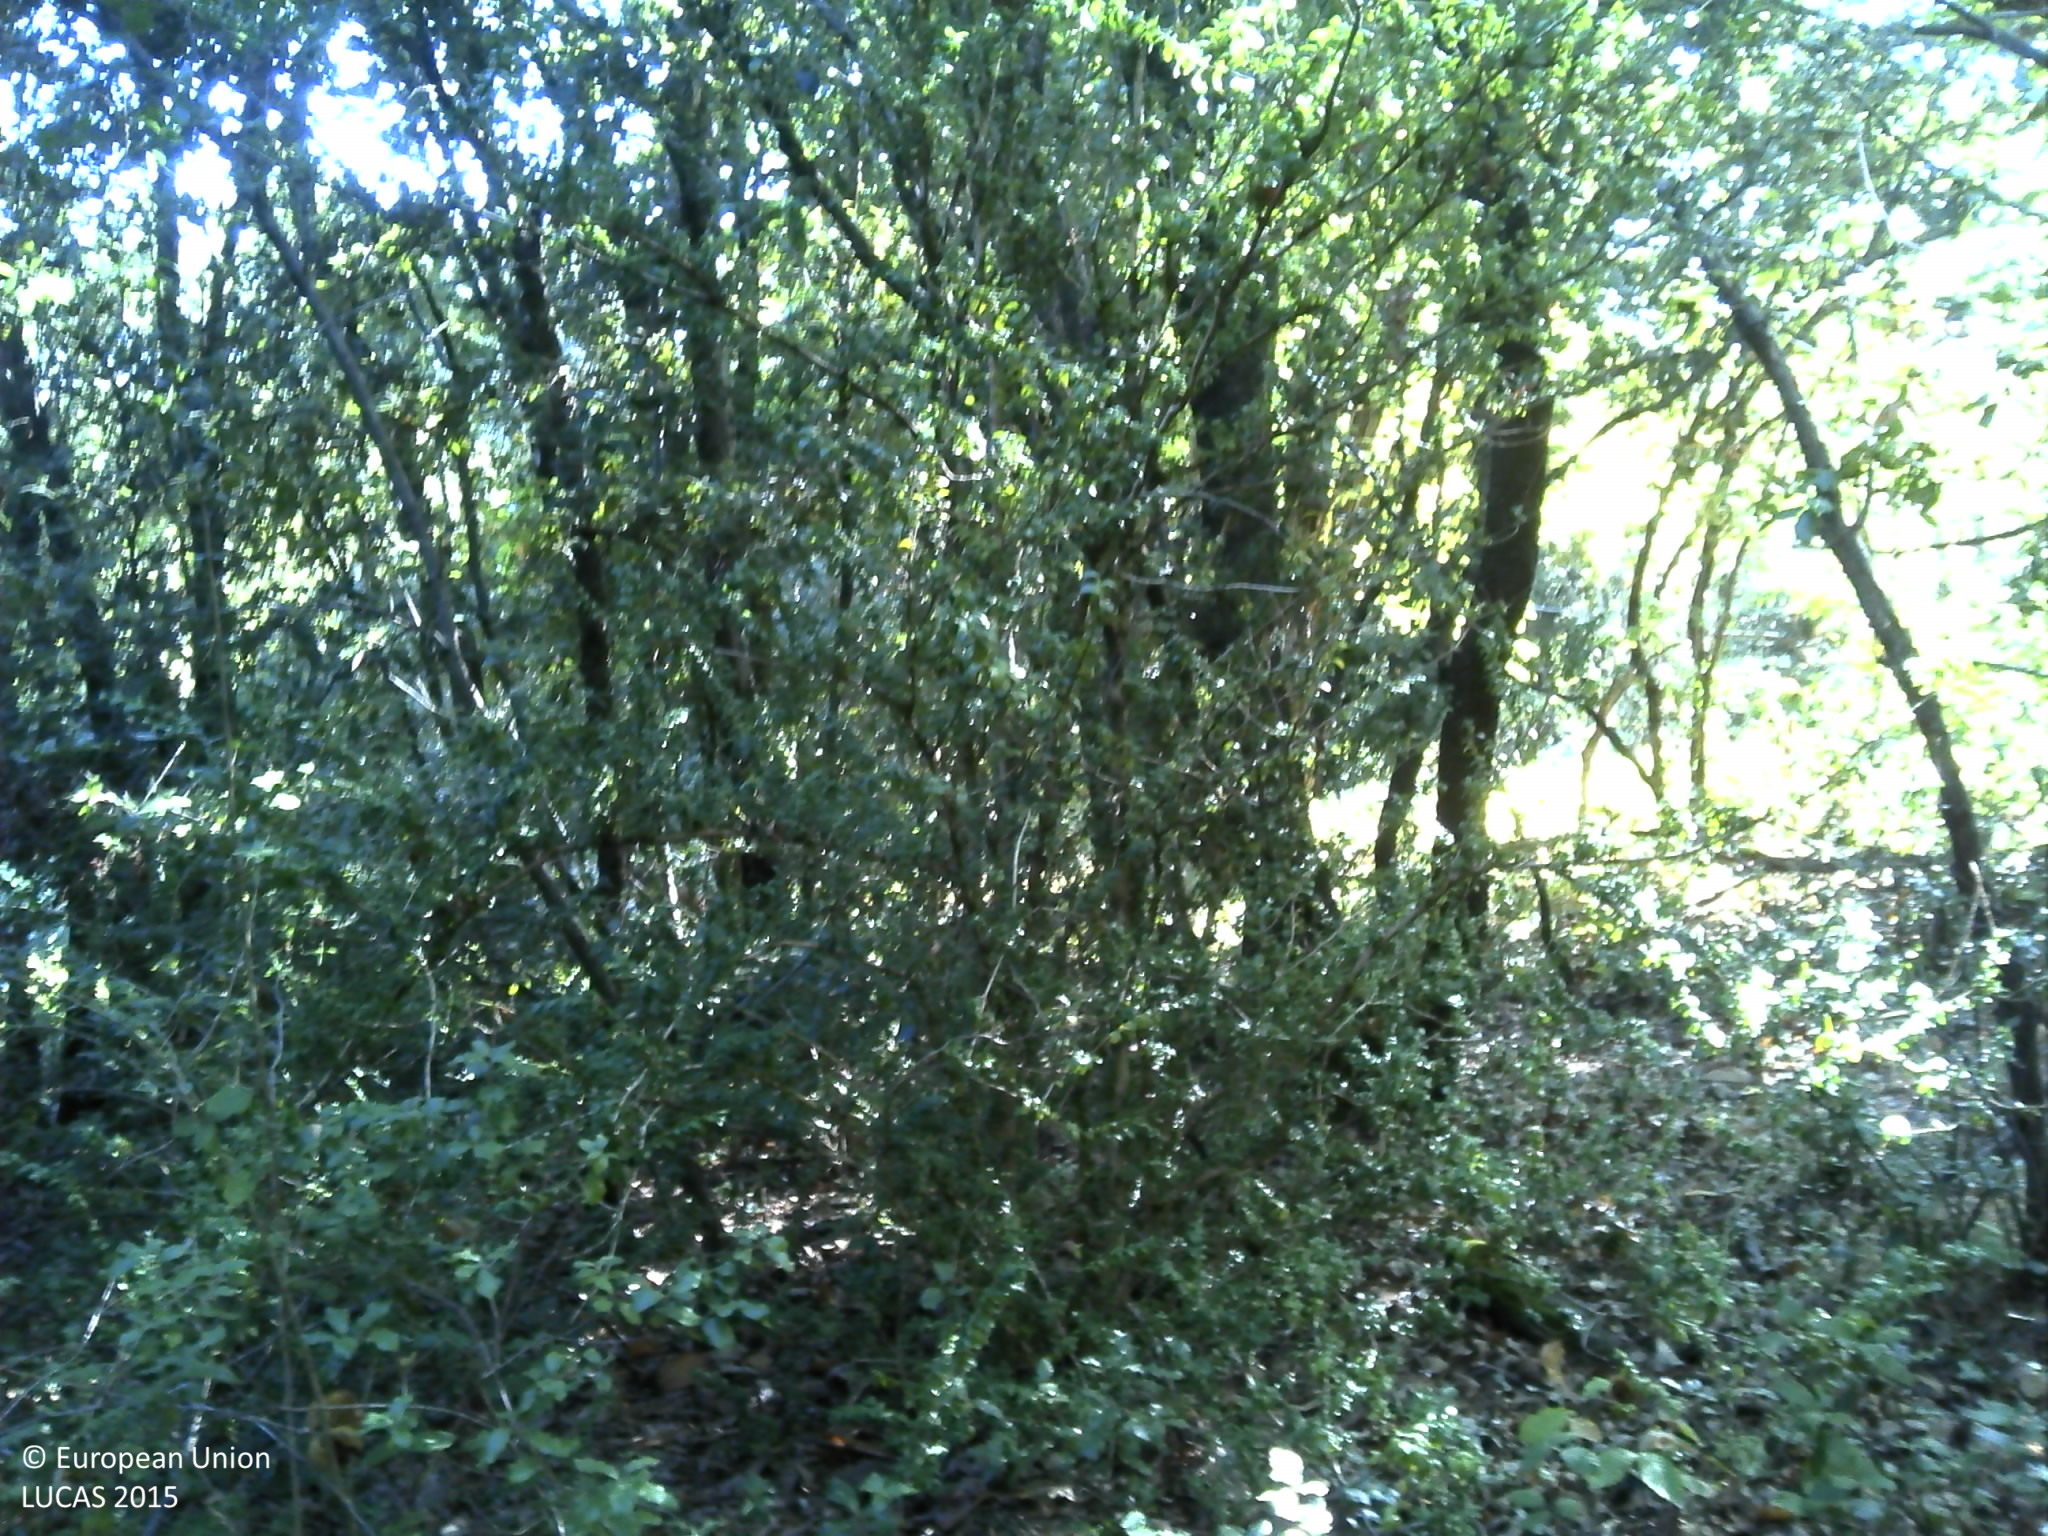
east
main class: Woodland
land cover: Broadleaved woodland
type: thermophilous deciduous forest
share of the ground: > 75 %
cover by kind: broadleaved forest trees 90 %, shrubs 5 %, herbaceous plants 5 %
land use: Forestry
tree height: > 5 m
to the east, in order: Broadleaved woodland; Tracks; Broadleaved woodland
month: October
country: FR
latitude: 43.5915
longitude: 3.3076
